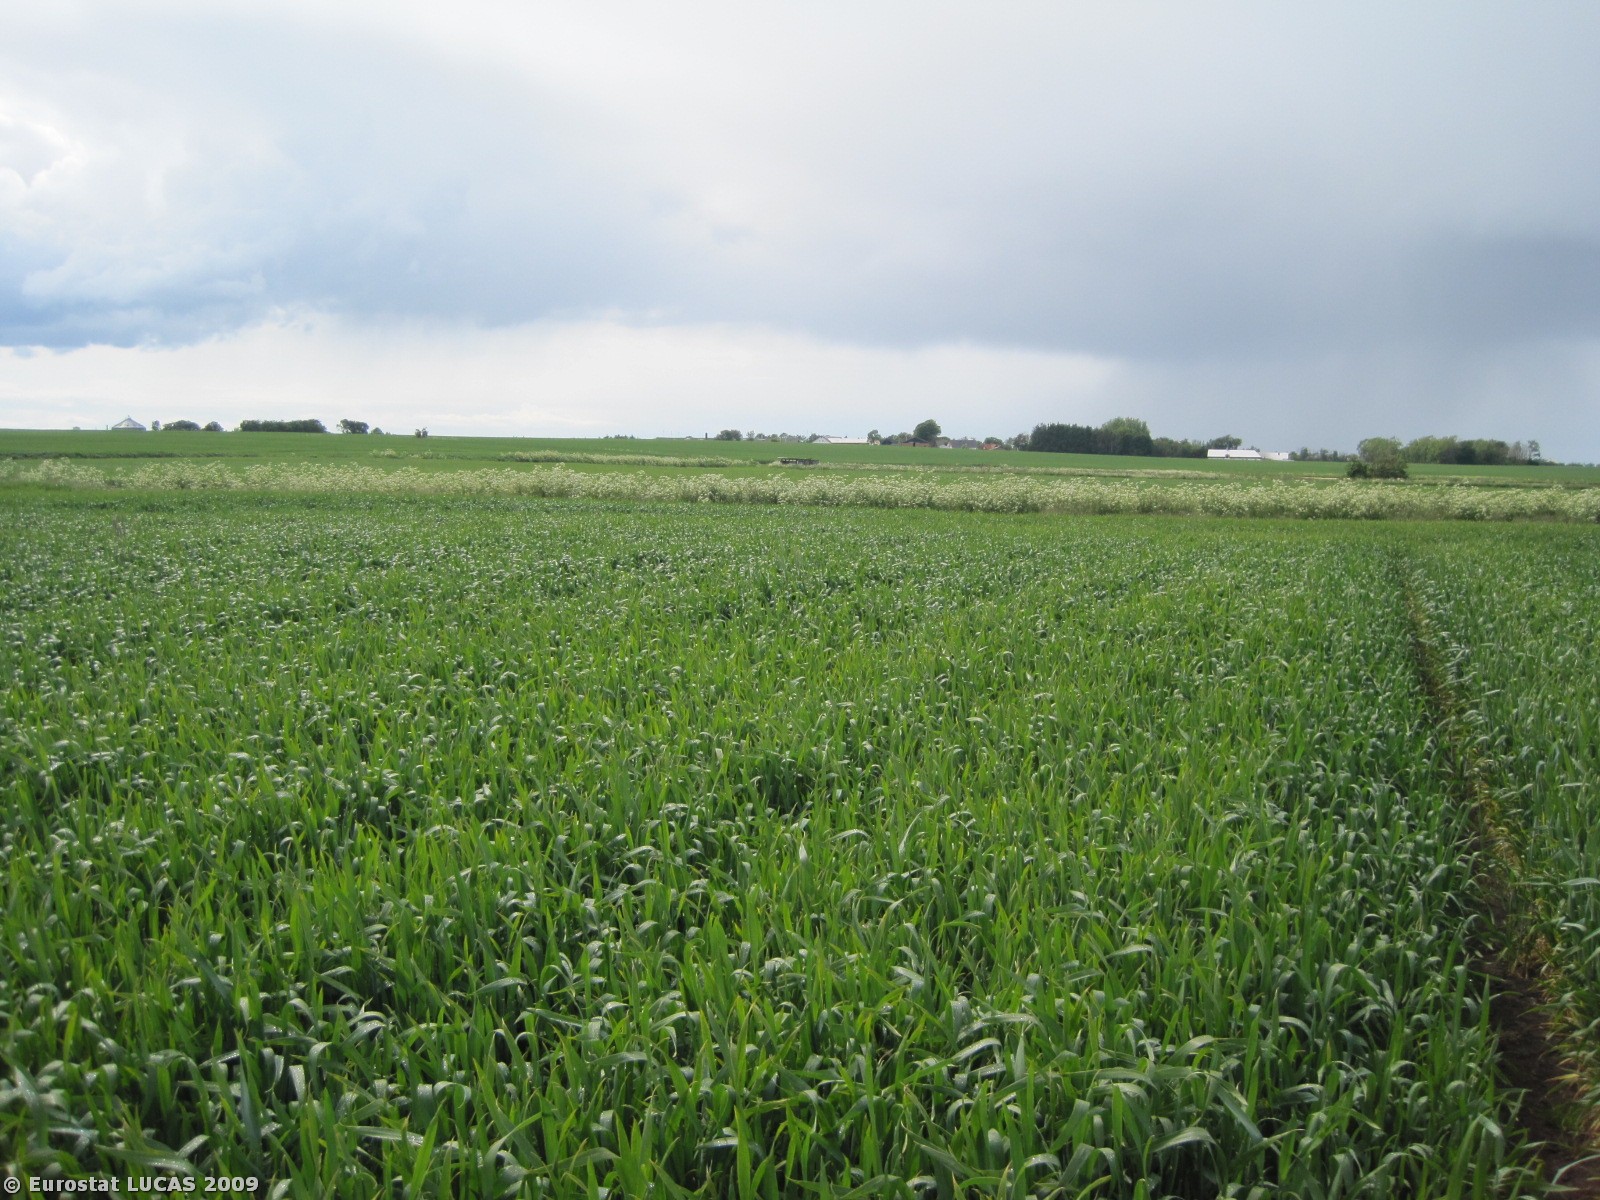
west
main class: Cropland
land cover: Common wheat
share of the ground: > 75 %
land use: Agriculture (excluding fallow land and kitchen gardens)
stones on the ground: < 10 %
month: June
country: DK
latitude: 57.3203
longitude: 9.8840
